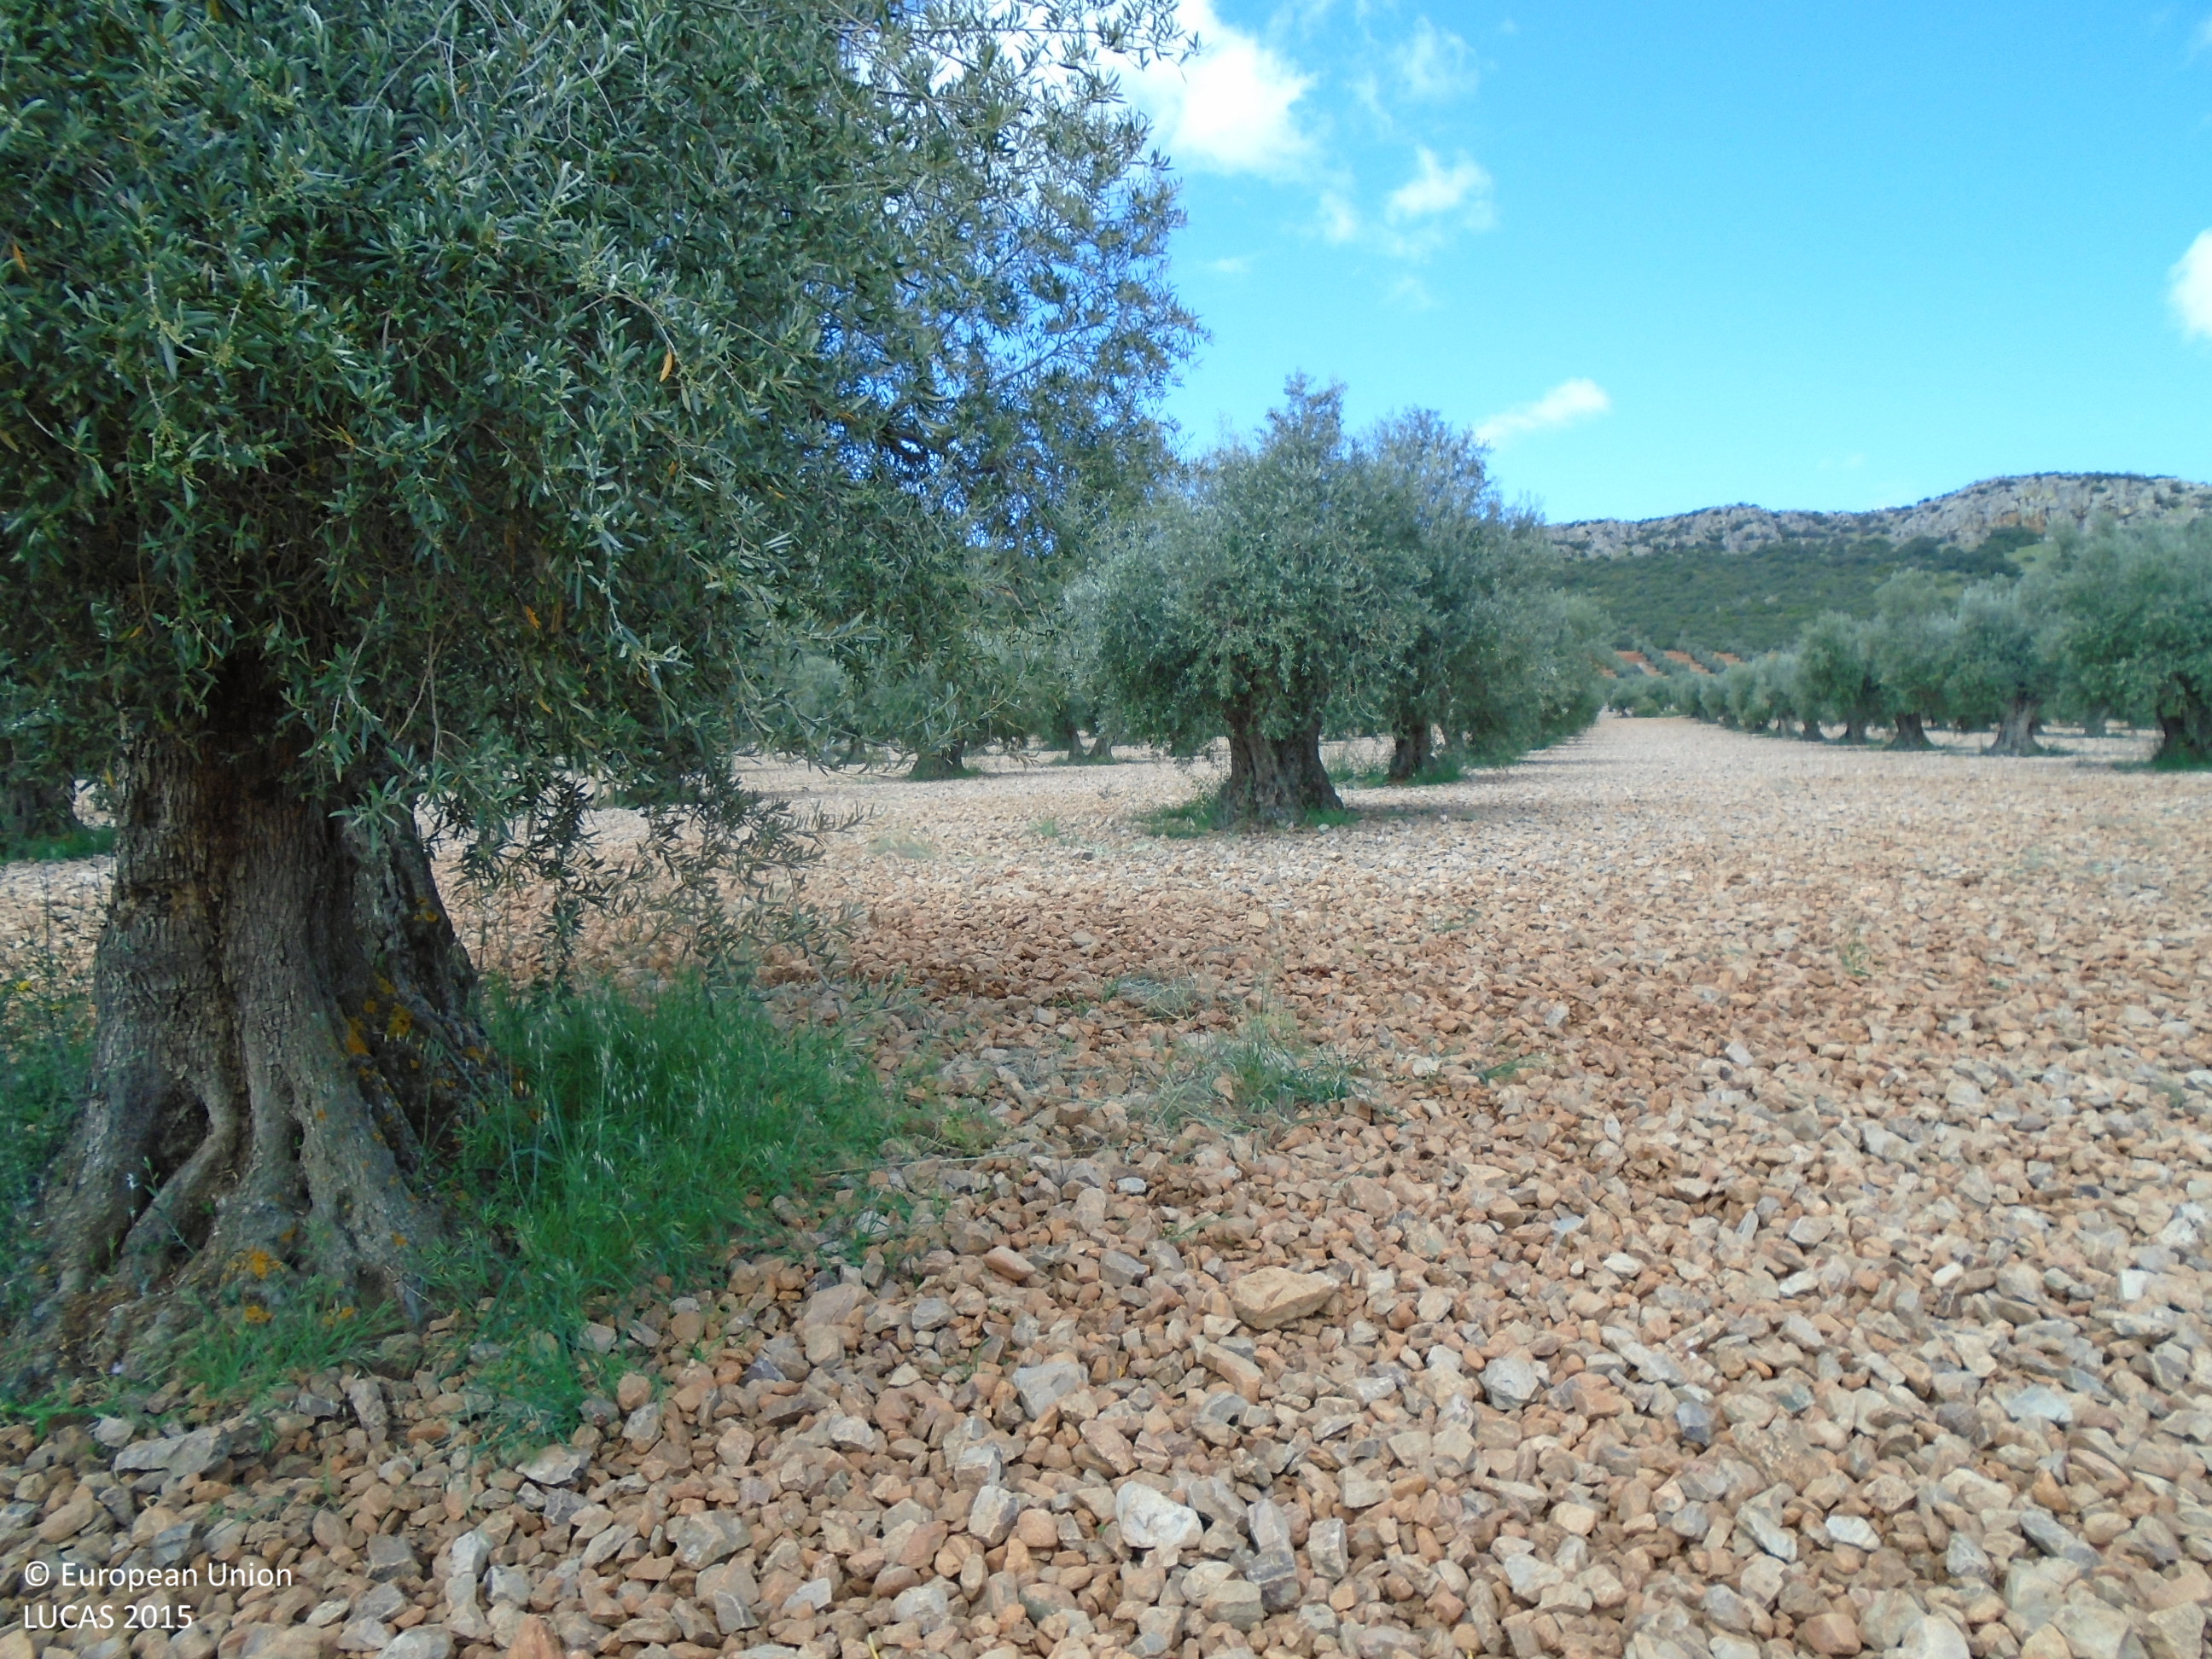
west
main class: Cropland
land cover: Olive groves
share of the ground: 10 - 25 %
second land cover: Other bare soil
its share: > 75 %
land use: Agriculture (excluding fallow land and kitchen gardens)
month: May
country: ES
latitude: 39.6498
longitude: -3.6973
